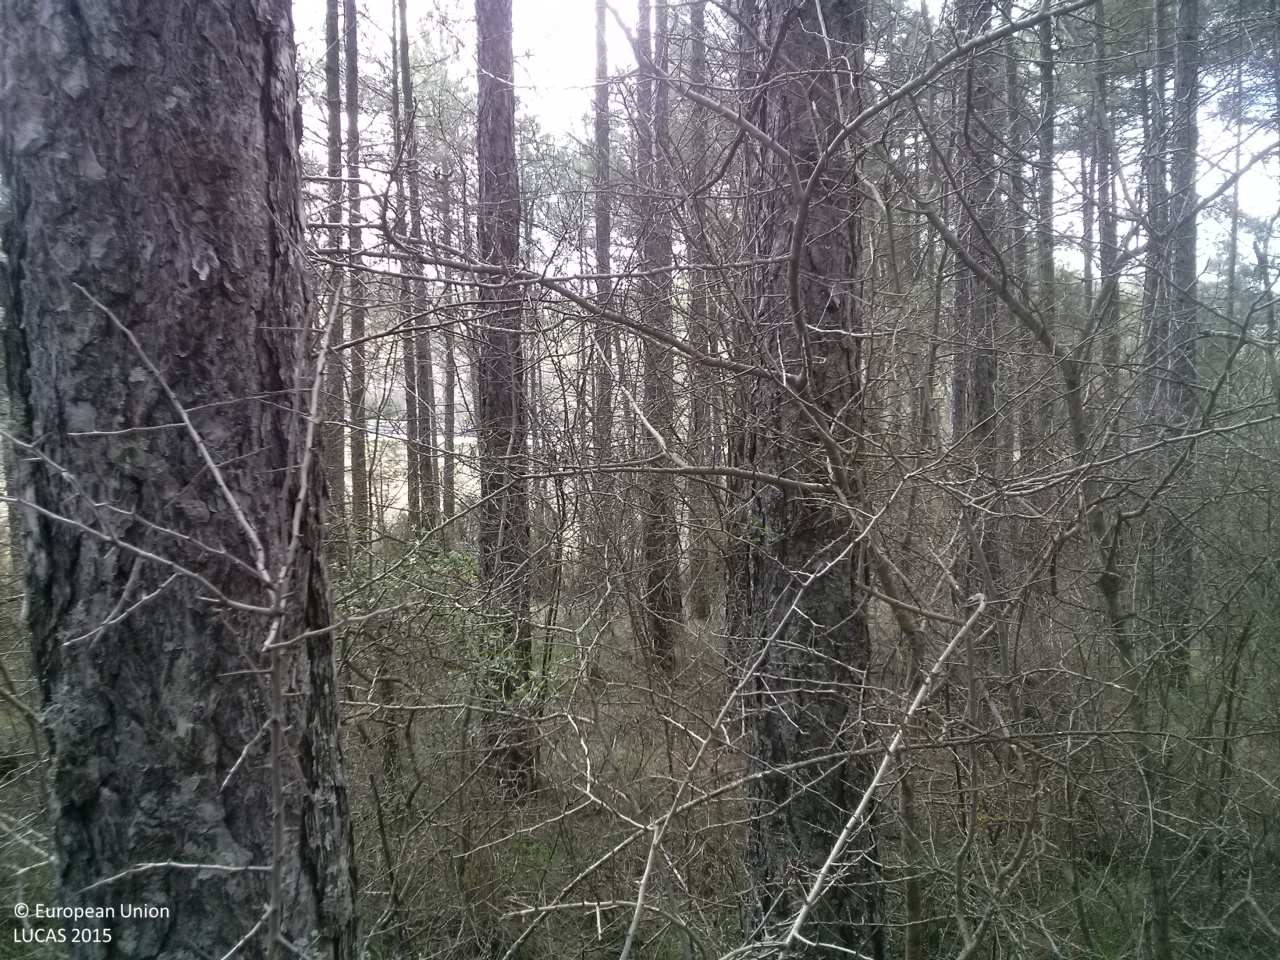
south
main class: Woodland
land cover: Pine dominated coniferous woodland
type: coniferous forest of the mediterranean region
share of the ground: > 75 %
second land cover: Shrubland without tree cover
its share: > 75 %
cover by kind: coniferous forest trees 75 %, shrubs 20 %, herbaceous plants 5 %
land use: Forestry
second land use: Agriculture (excluding fallow land and kitchen gardens)
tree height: > 5 m
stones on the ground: < 10 %
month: April
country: ES
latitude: 40.2168
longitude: -1.8951
